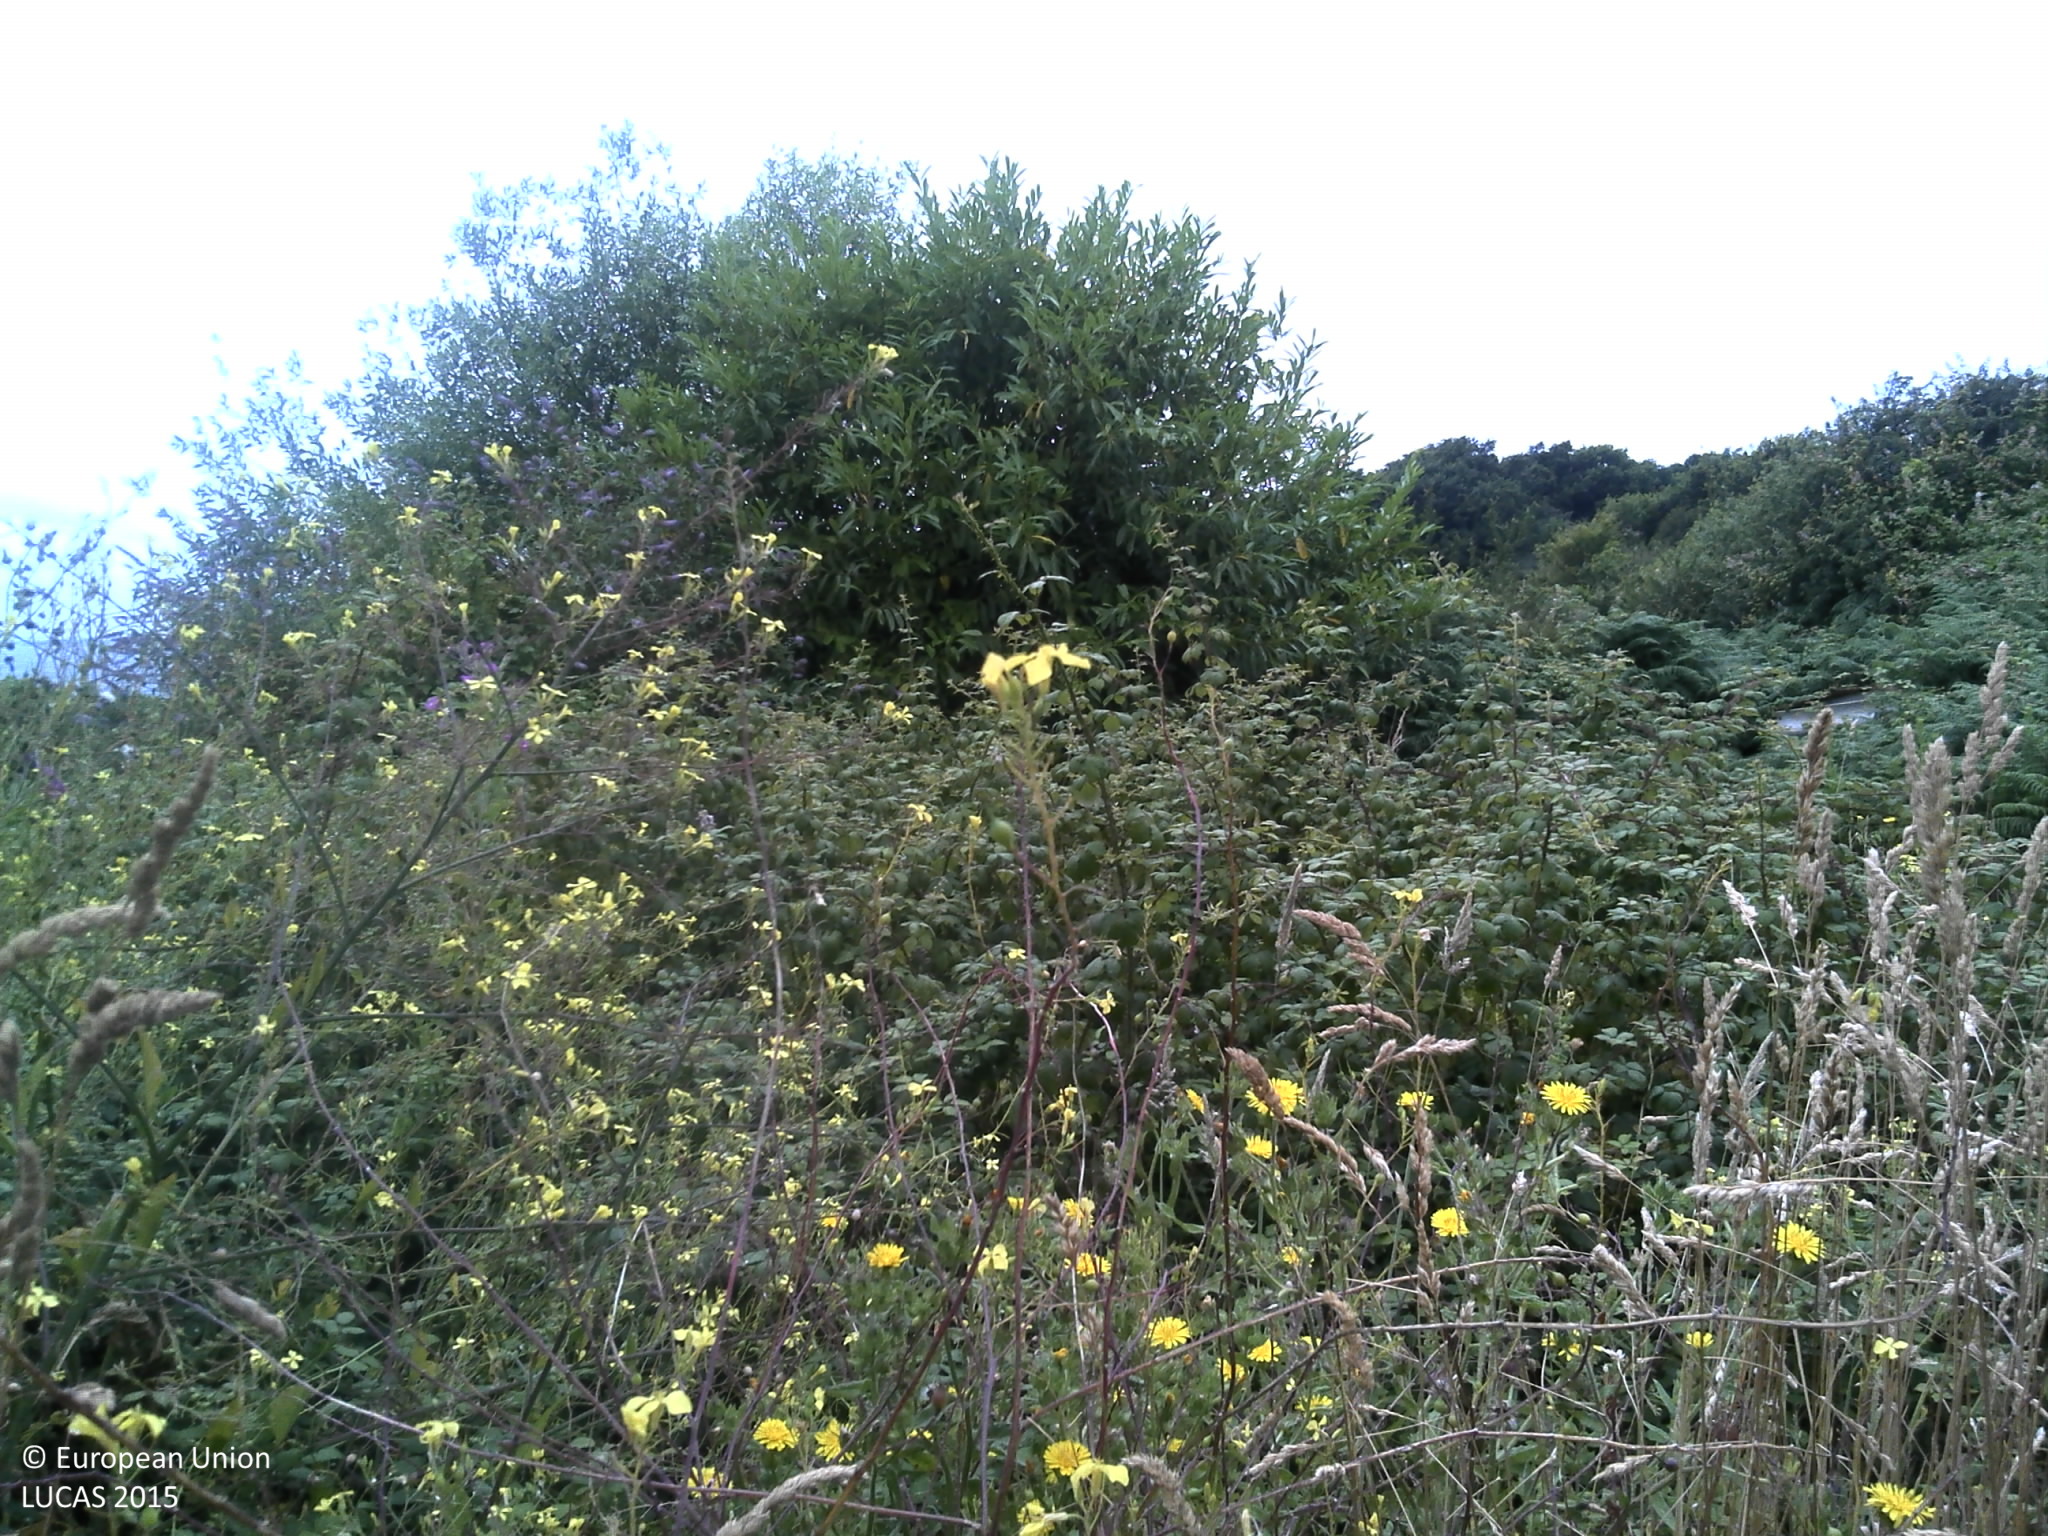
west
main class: Shrubland
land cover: Shrubland without tree cover
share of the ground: > 75 %
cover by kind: shrubs 80 %, herbaceous plants 20 %
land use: Semi-natural and natural areas not in use
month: July
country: FR
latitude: 48.3449
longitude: -4.4397
